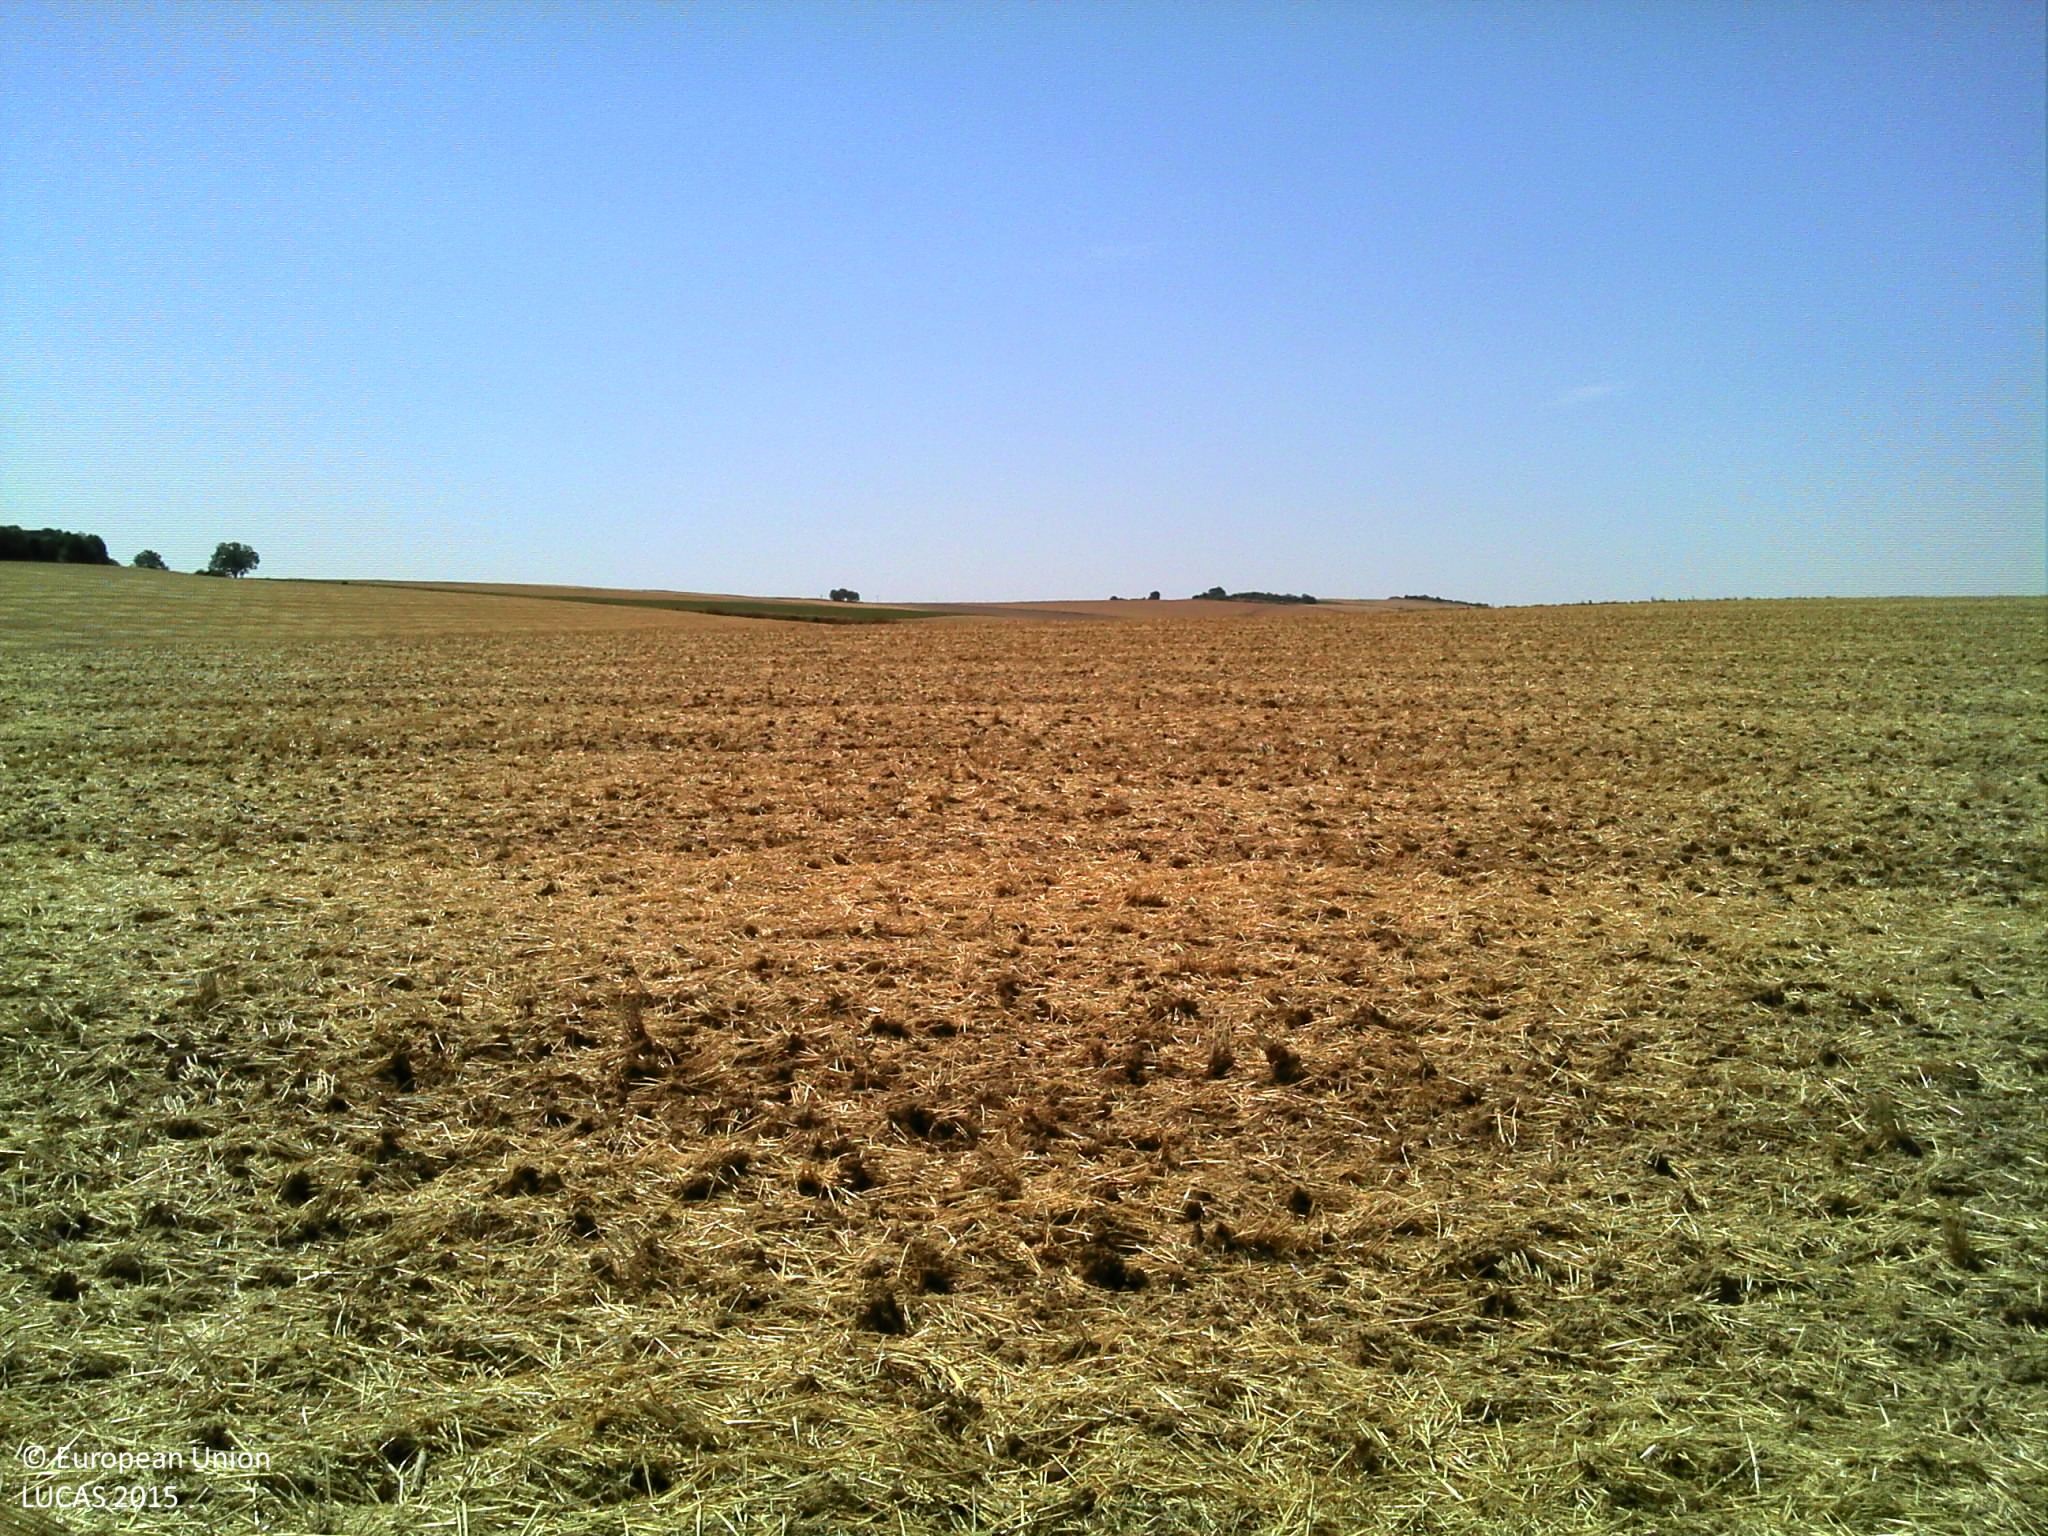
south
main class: Cropland
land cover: Common wheat
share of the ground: > 75 %
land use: Agriculture (excluding fallow land and kitchen gardens)
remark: Tilled/Sowed
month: August
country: FR
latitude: 47.9189
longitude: 3.4245
